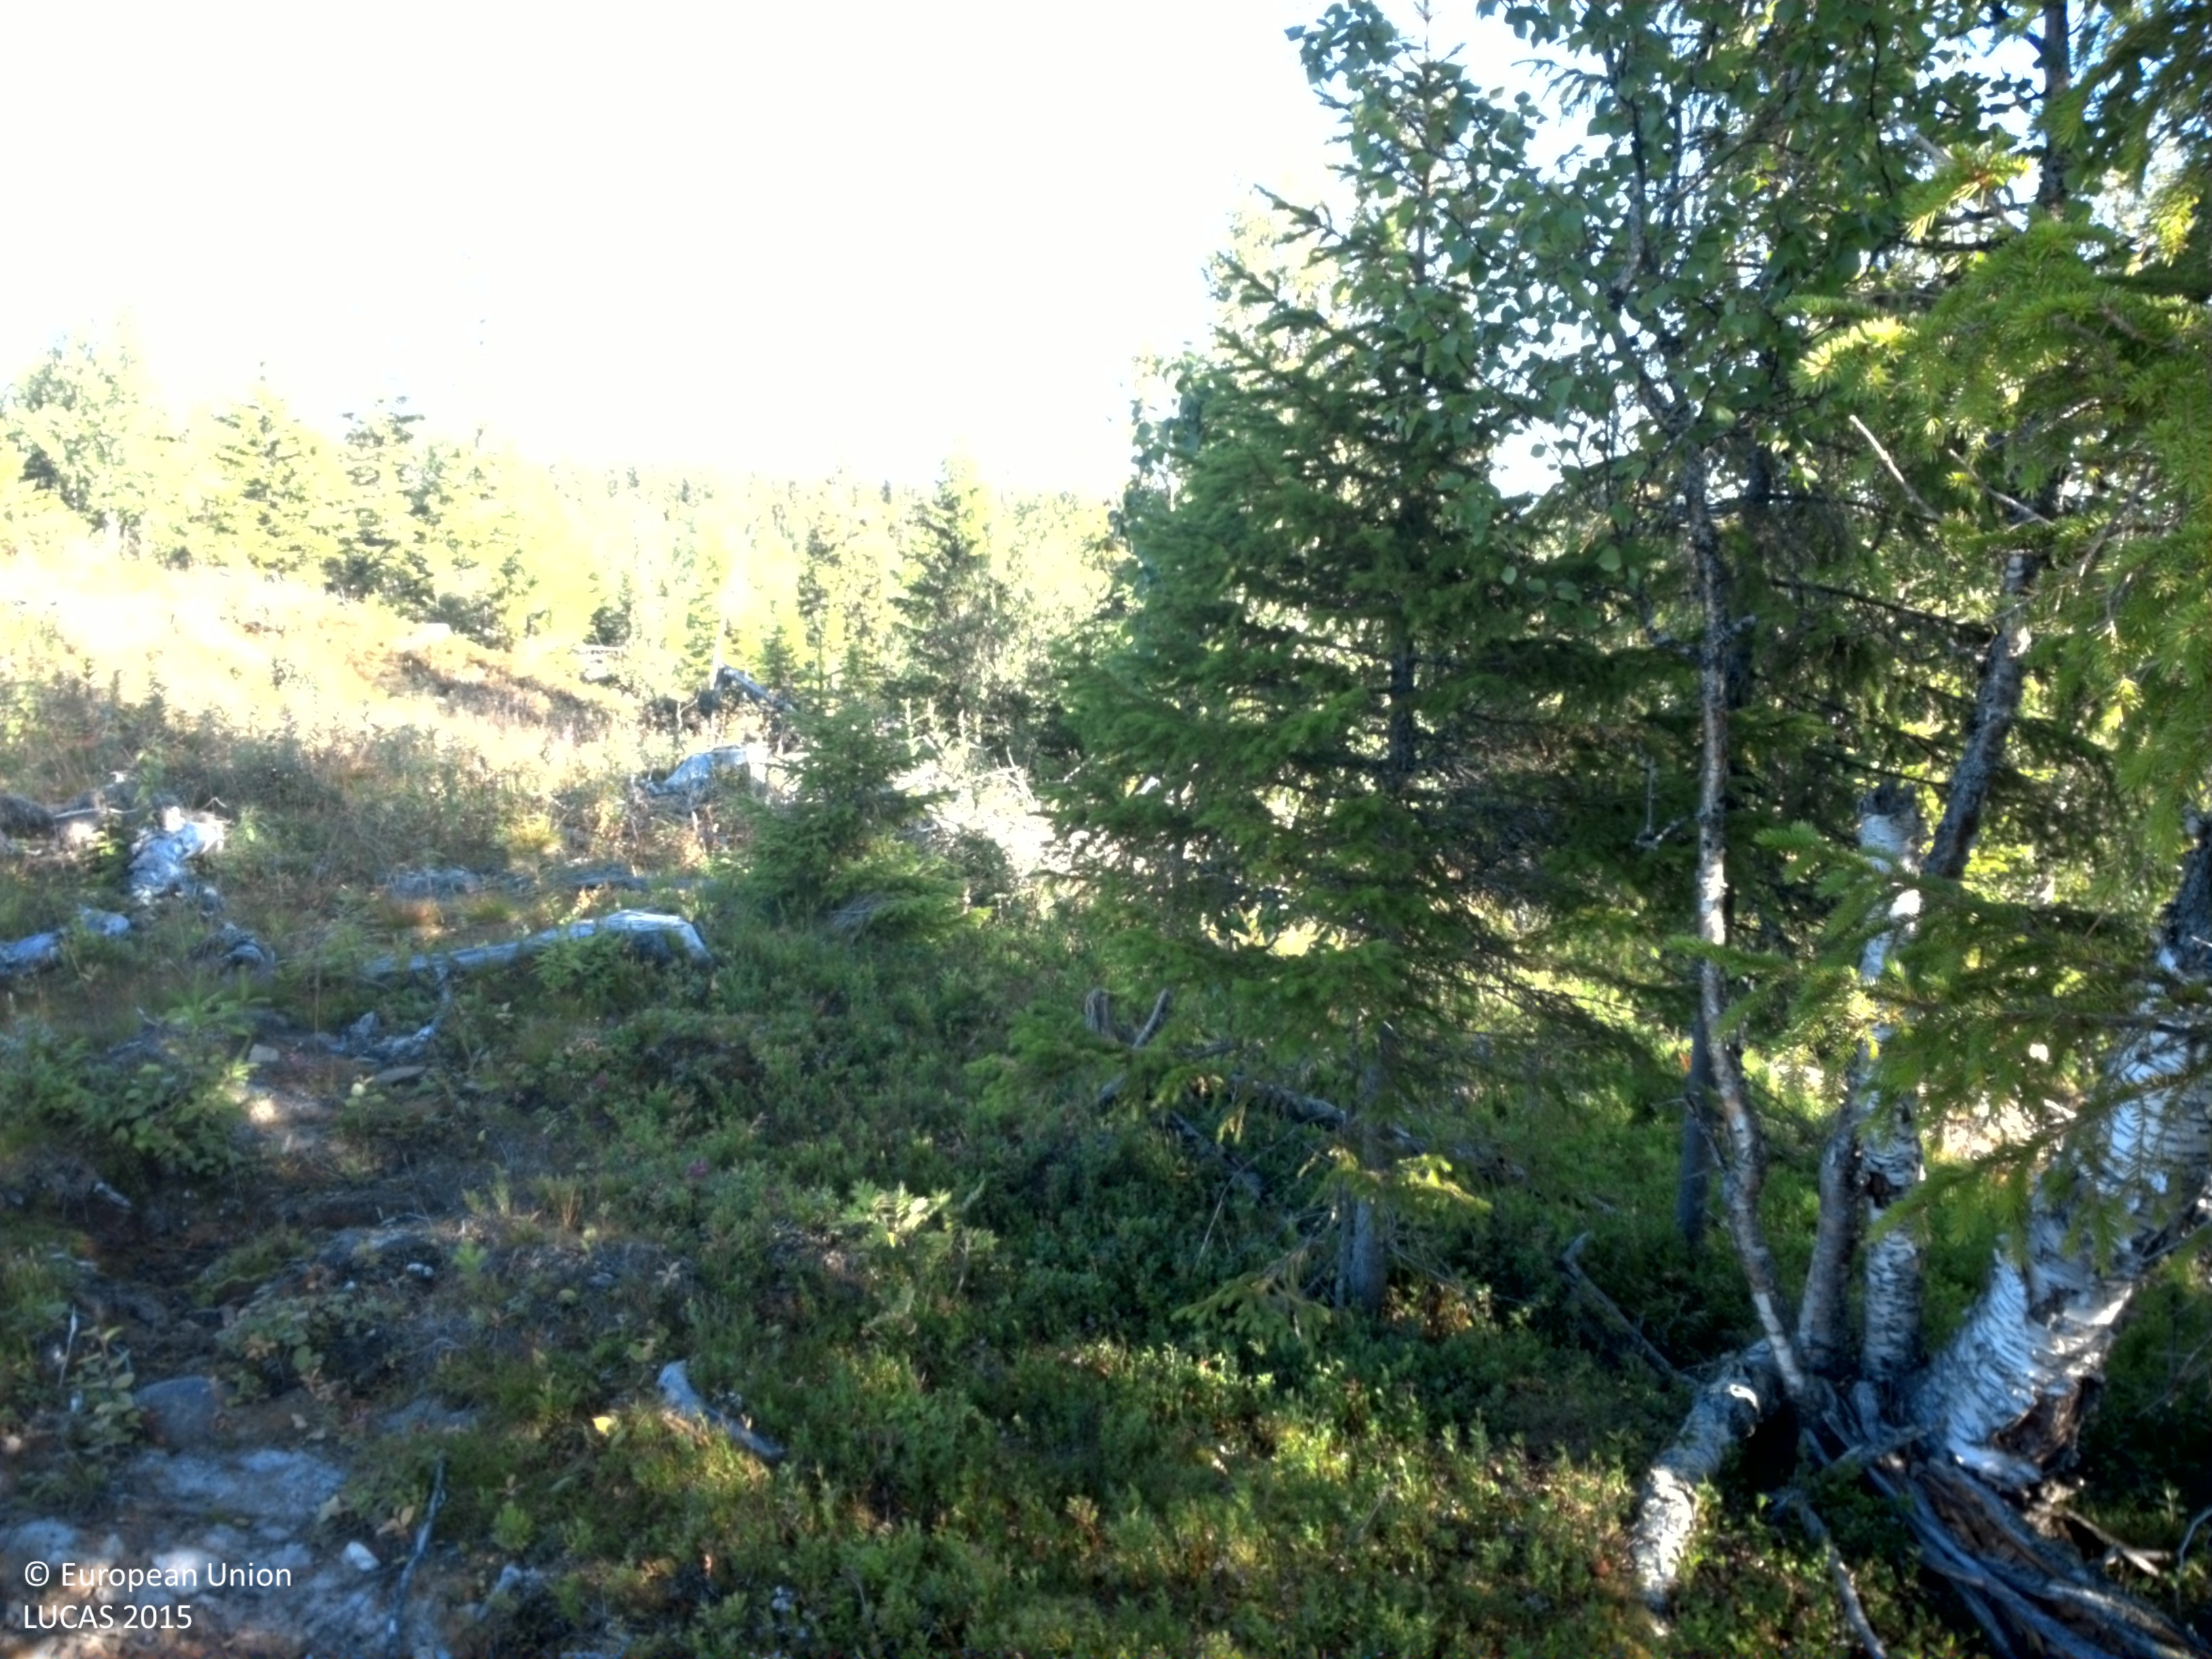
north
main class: Shrubland
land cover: Shrubland with sparse tree cover
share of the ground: 10 - 25 %
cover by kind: herbaceous plants 65 %, shrubs 20 %, broadleaved forest trees 5 %, lichens and mosses 5 %, unconsolidated bare surface 5 %
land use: Forestry
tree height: < 5 m
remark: Clear cut
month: September
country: SE
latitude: 65.2216
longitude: 16.1441
